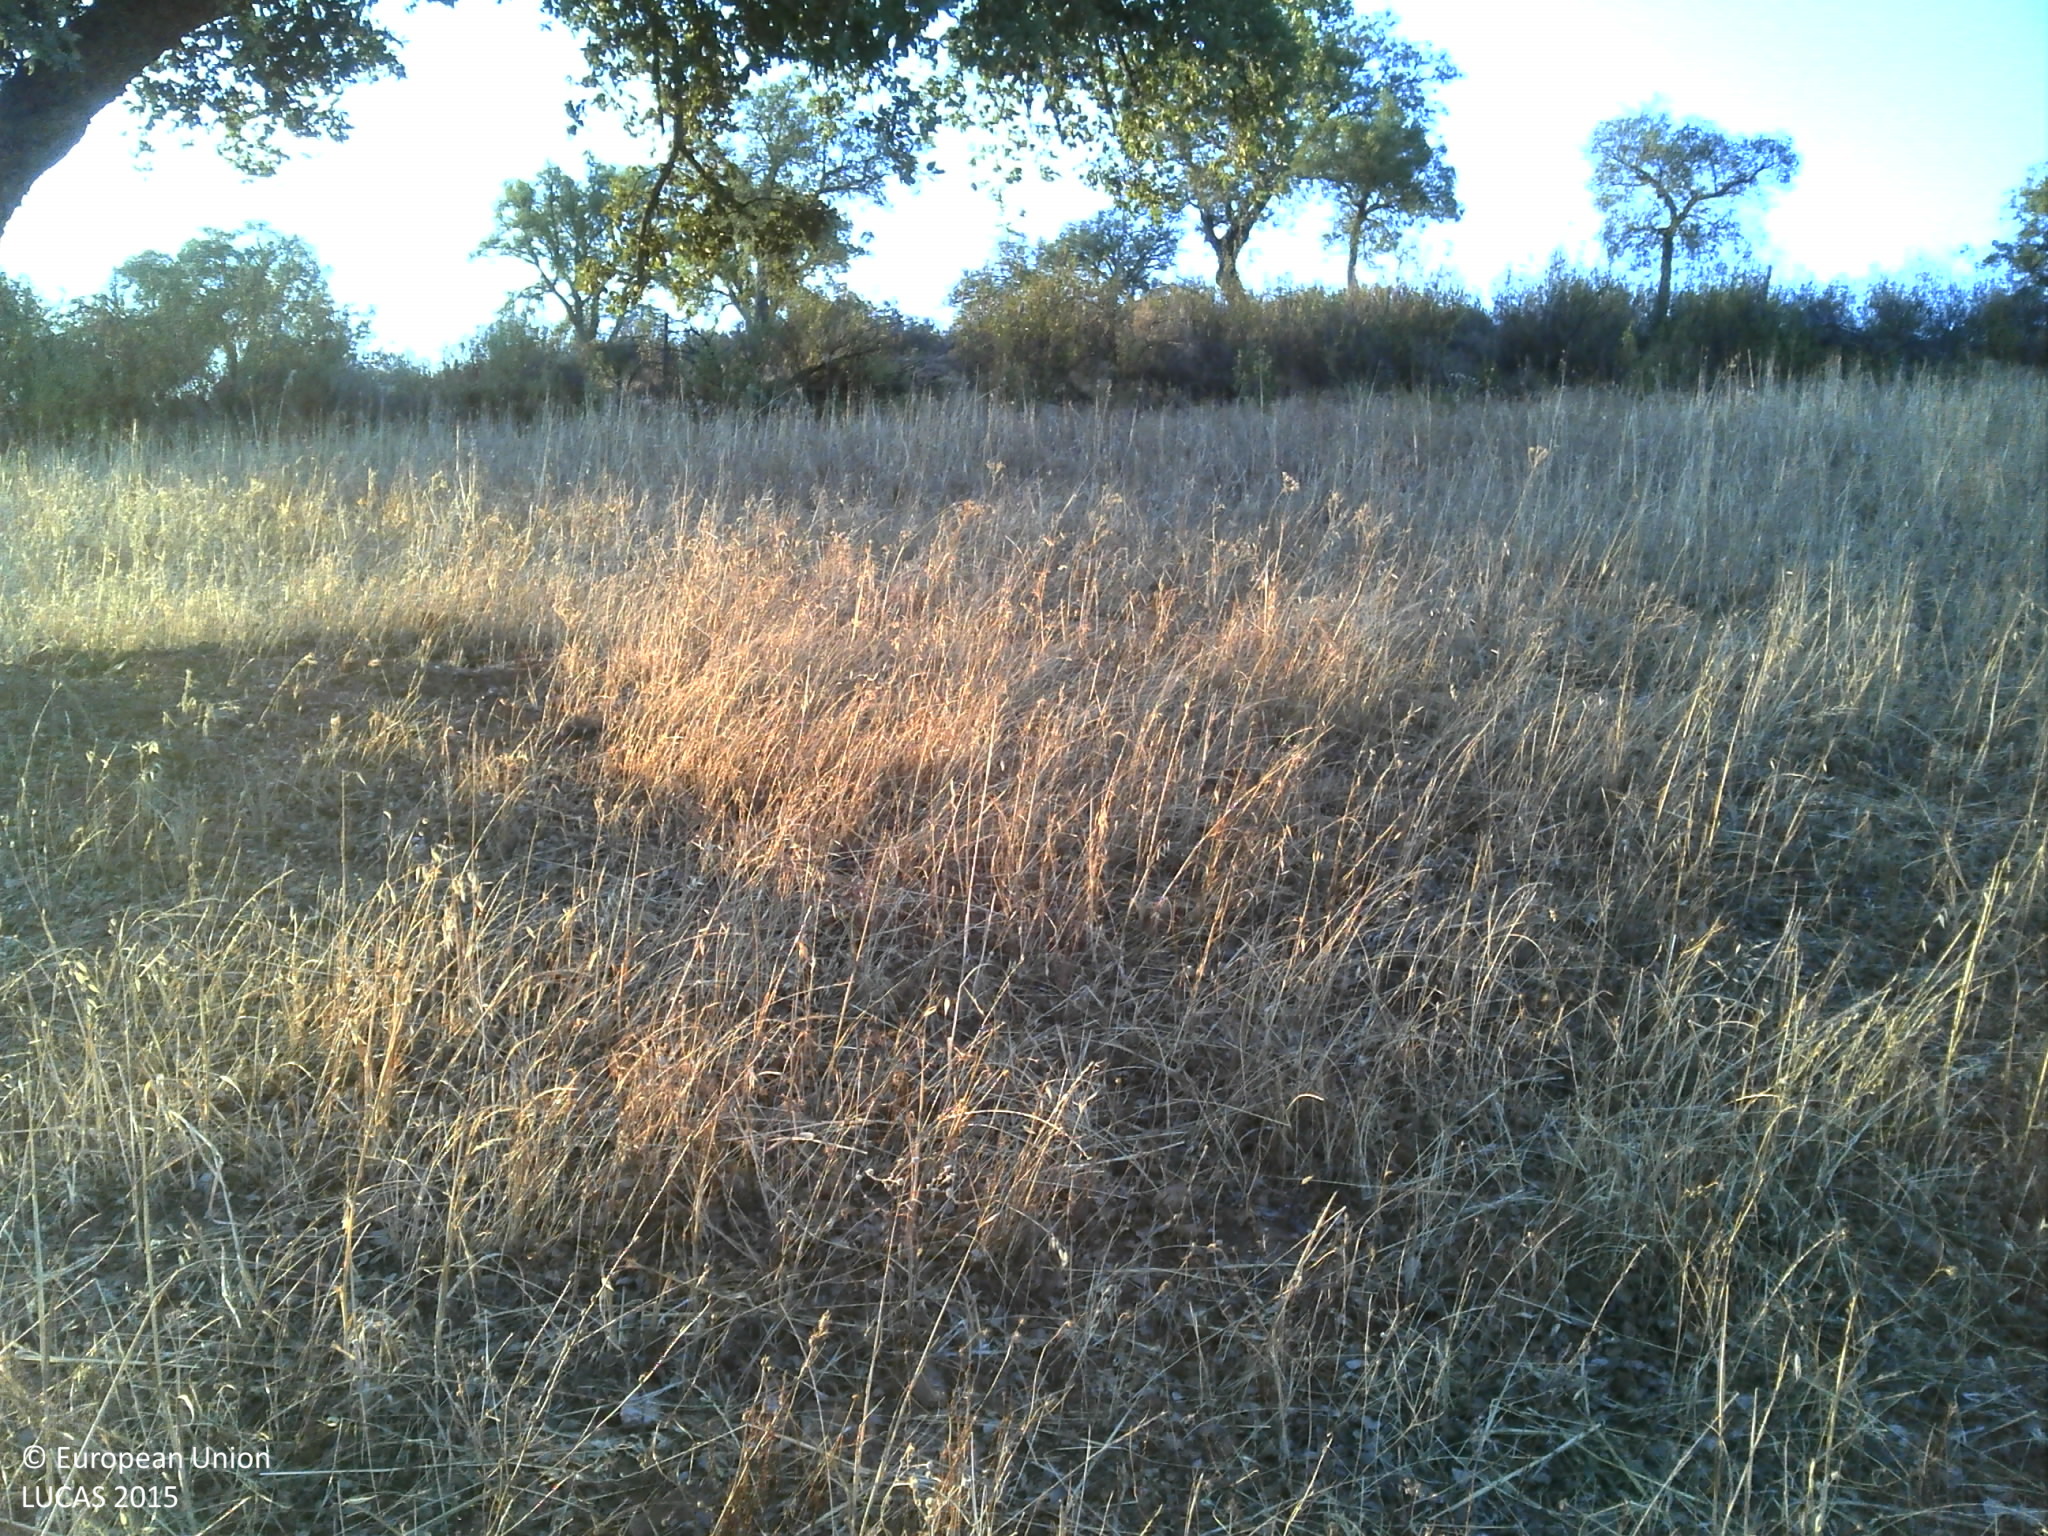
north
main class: Woodland
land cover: Broadleaved woodland
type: broadleaved evergreen forest
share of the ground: 10 - 25 %
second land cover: Spontaneously vegetated surfaces
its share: 50 - 75 %
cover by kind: herbaceous plants 50 %, broadleaved forest trees 25 %, unconsolidated bare surface 25 %
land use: Forestry
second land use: Agriculture (excluding fallow land and kitchen gardens)
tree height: > 5 m
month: June
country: PT
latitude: 37.8851
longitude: -7.3068
